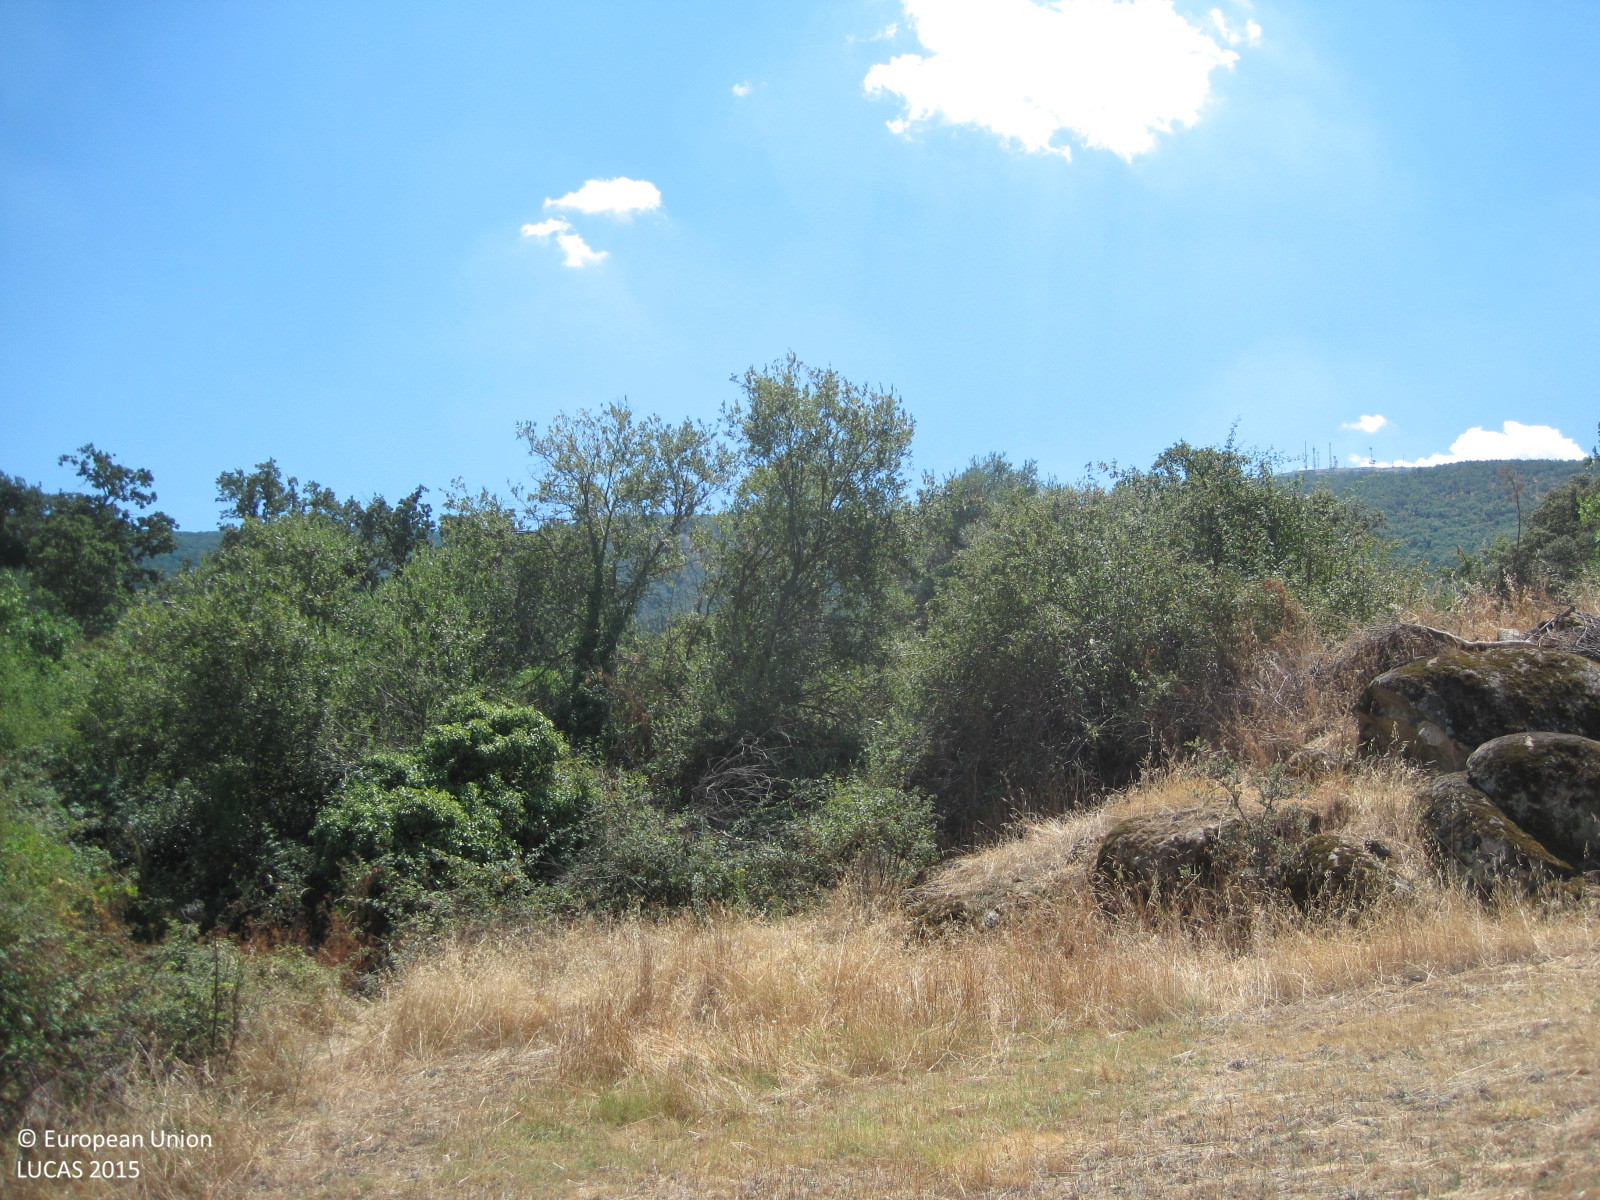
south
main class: Woodland
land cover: Broadleaved woodland
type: floodplain forest
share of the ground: 25 - 50 %
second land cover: Grassland without tree/shrub cover
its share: > 75 %
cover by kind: herbaceous plants 55 %, broadleaved forest trees 40 %, shrubs 5 %
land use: Forestry
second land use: Agriculture (excluding fallow land and kitchen gardens)
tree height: < 5 m
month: July
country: ES
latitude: 40.1750
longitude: -4.7403
